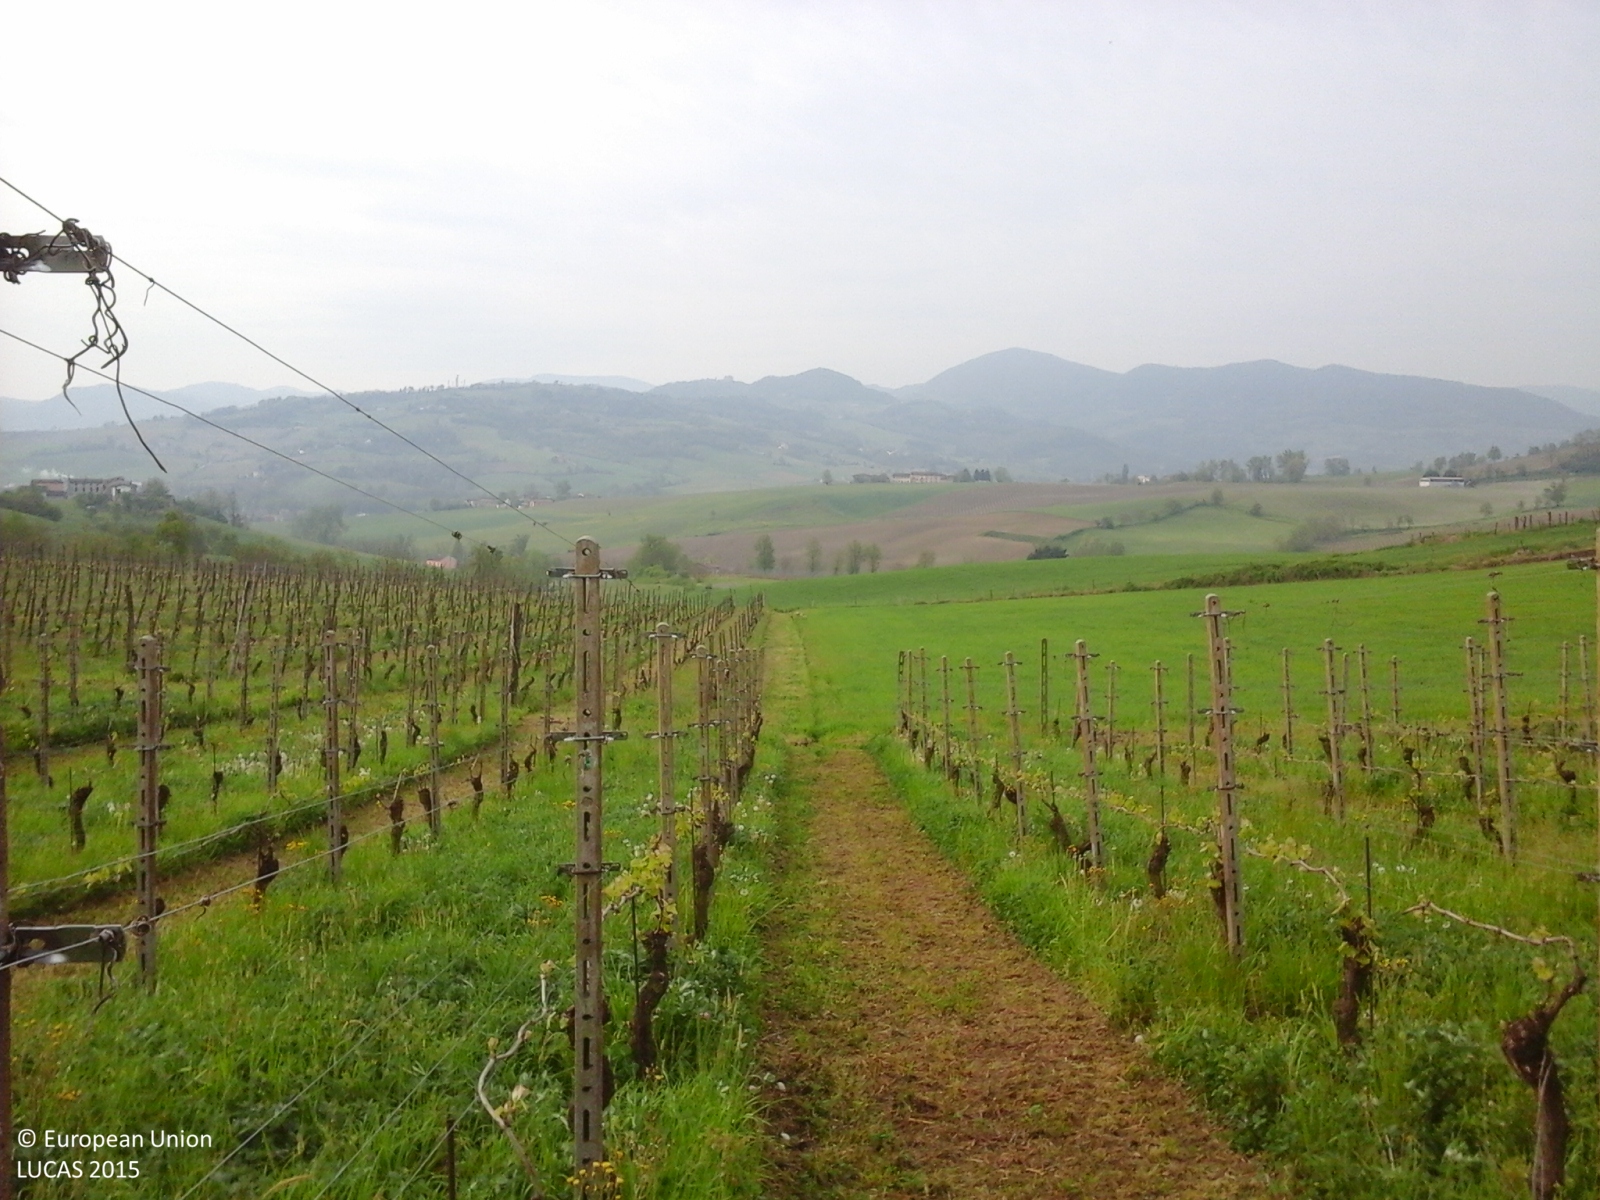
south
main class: Cropland
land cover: Vineyards
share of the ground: < 10 %
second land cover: Grassland without tree/shrub cover
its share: > 75 %
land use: Agriculture (excluding fallow land and kitchen gardens)
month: April
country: IT
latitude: 44.9618
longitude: 9.3800
